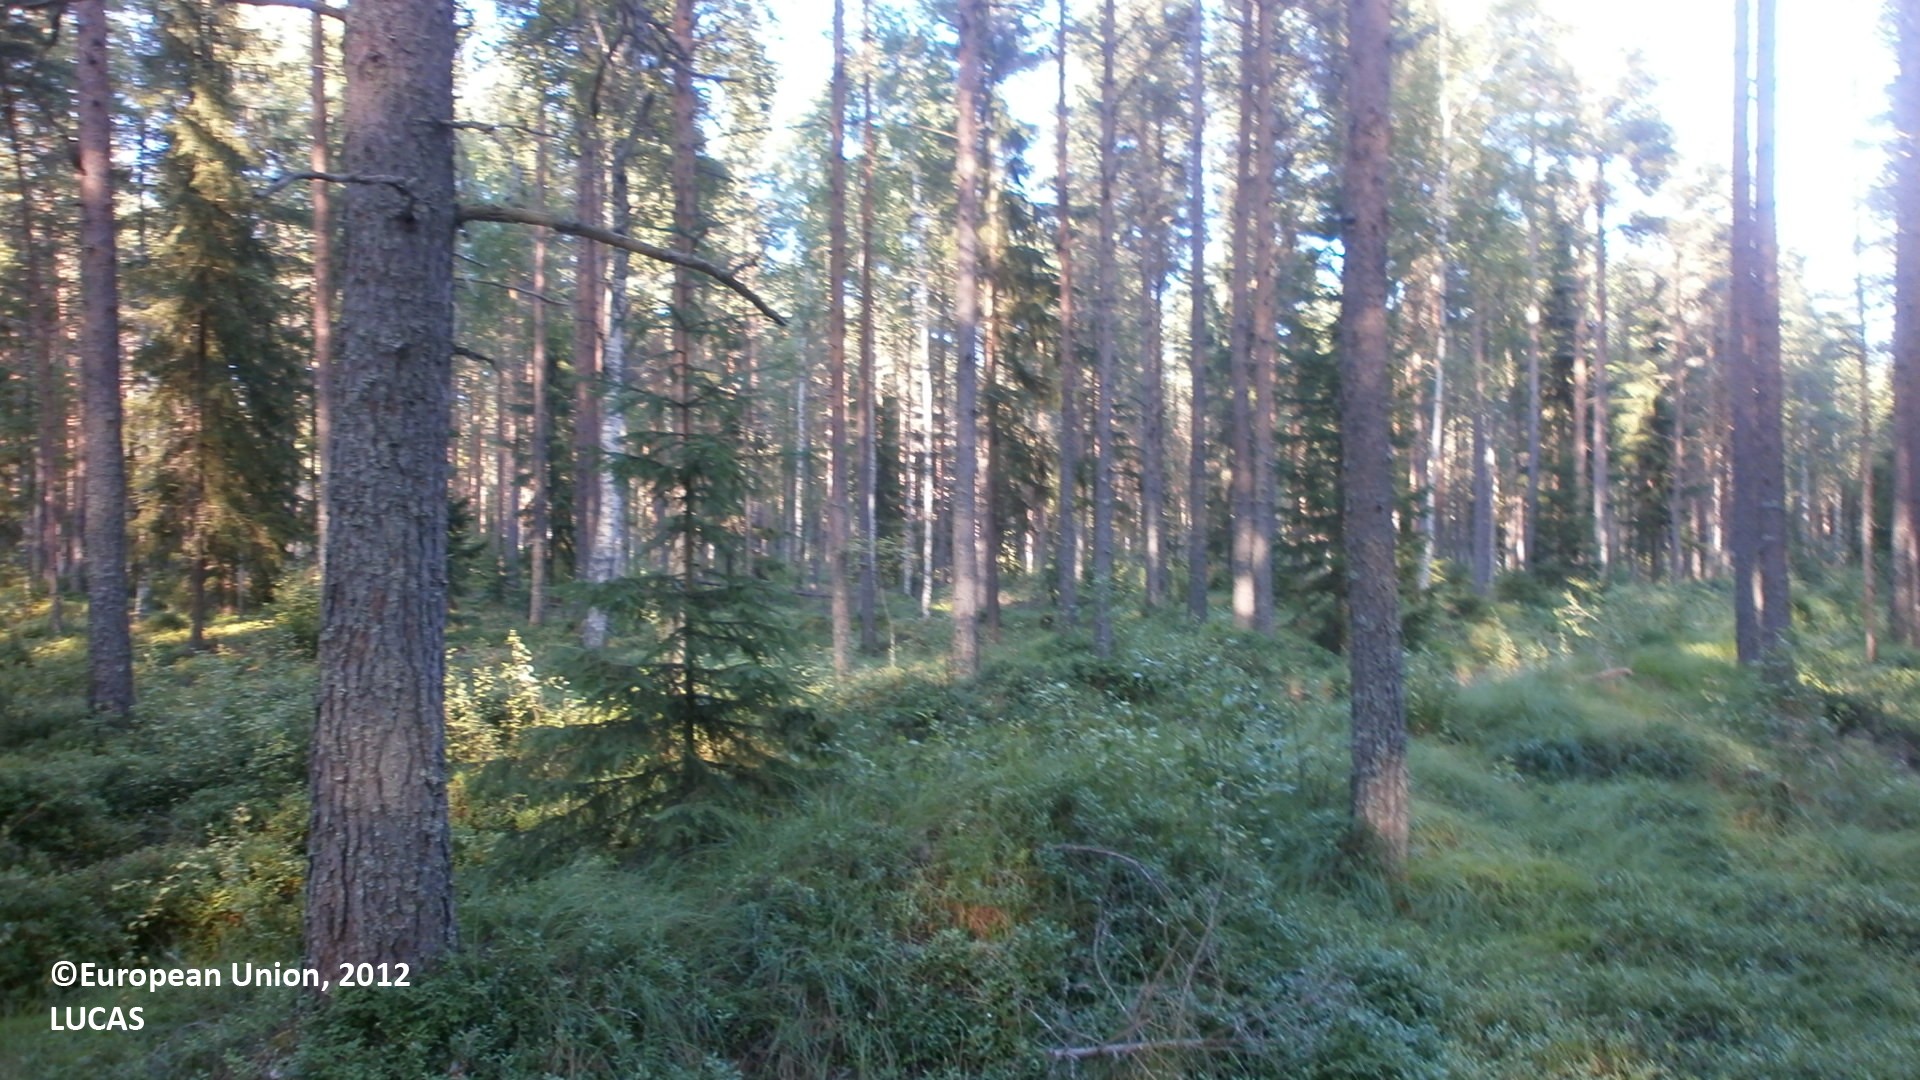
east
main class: Woodland
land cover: Pine dominated mixed woodland
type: boreal forest
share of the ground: 50 - 75 %
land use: Forestry
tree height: > 5 m
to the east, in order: Pine dominated mixed woodland; Ditches and canals; Pine dominated coniferous woodland; Ditches and canals; Pine dominated coniferous woodland; Ditches and canals; Pine dominated coniferous woodland; Tracks; Pine dominated coniferous woodland; Tracks; Pine dominated mixed woodland; Ditches and canals; Pine dominated coniferous woodland; Pine dominated mixed woodland; Ditches and canals
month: July
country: FI
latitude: 64.0484
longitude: 24.0129
